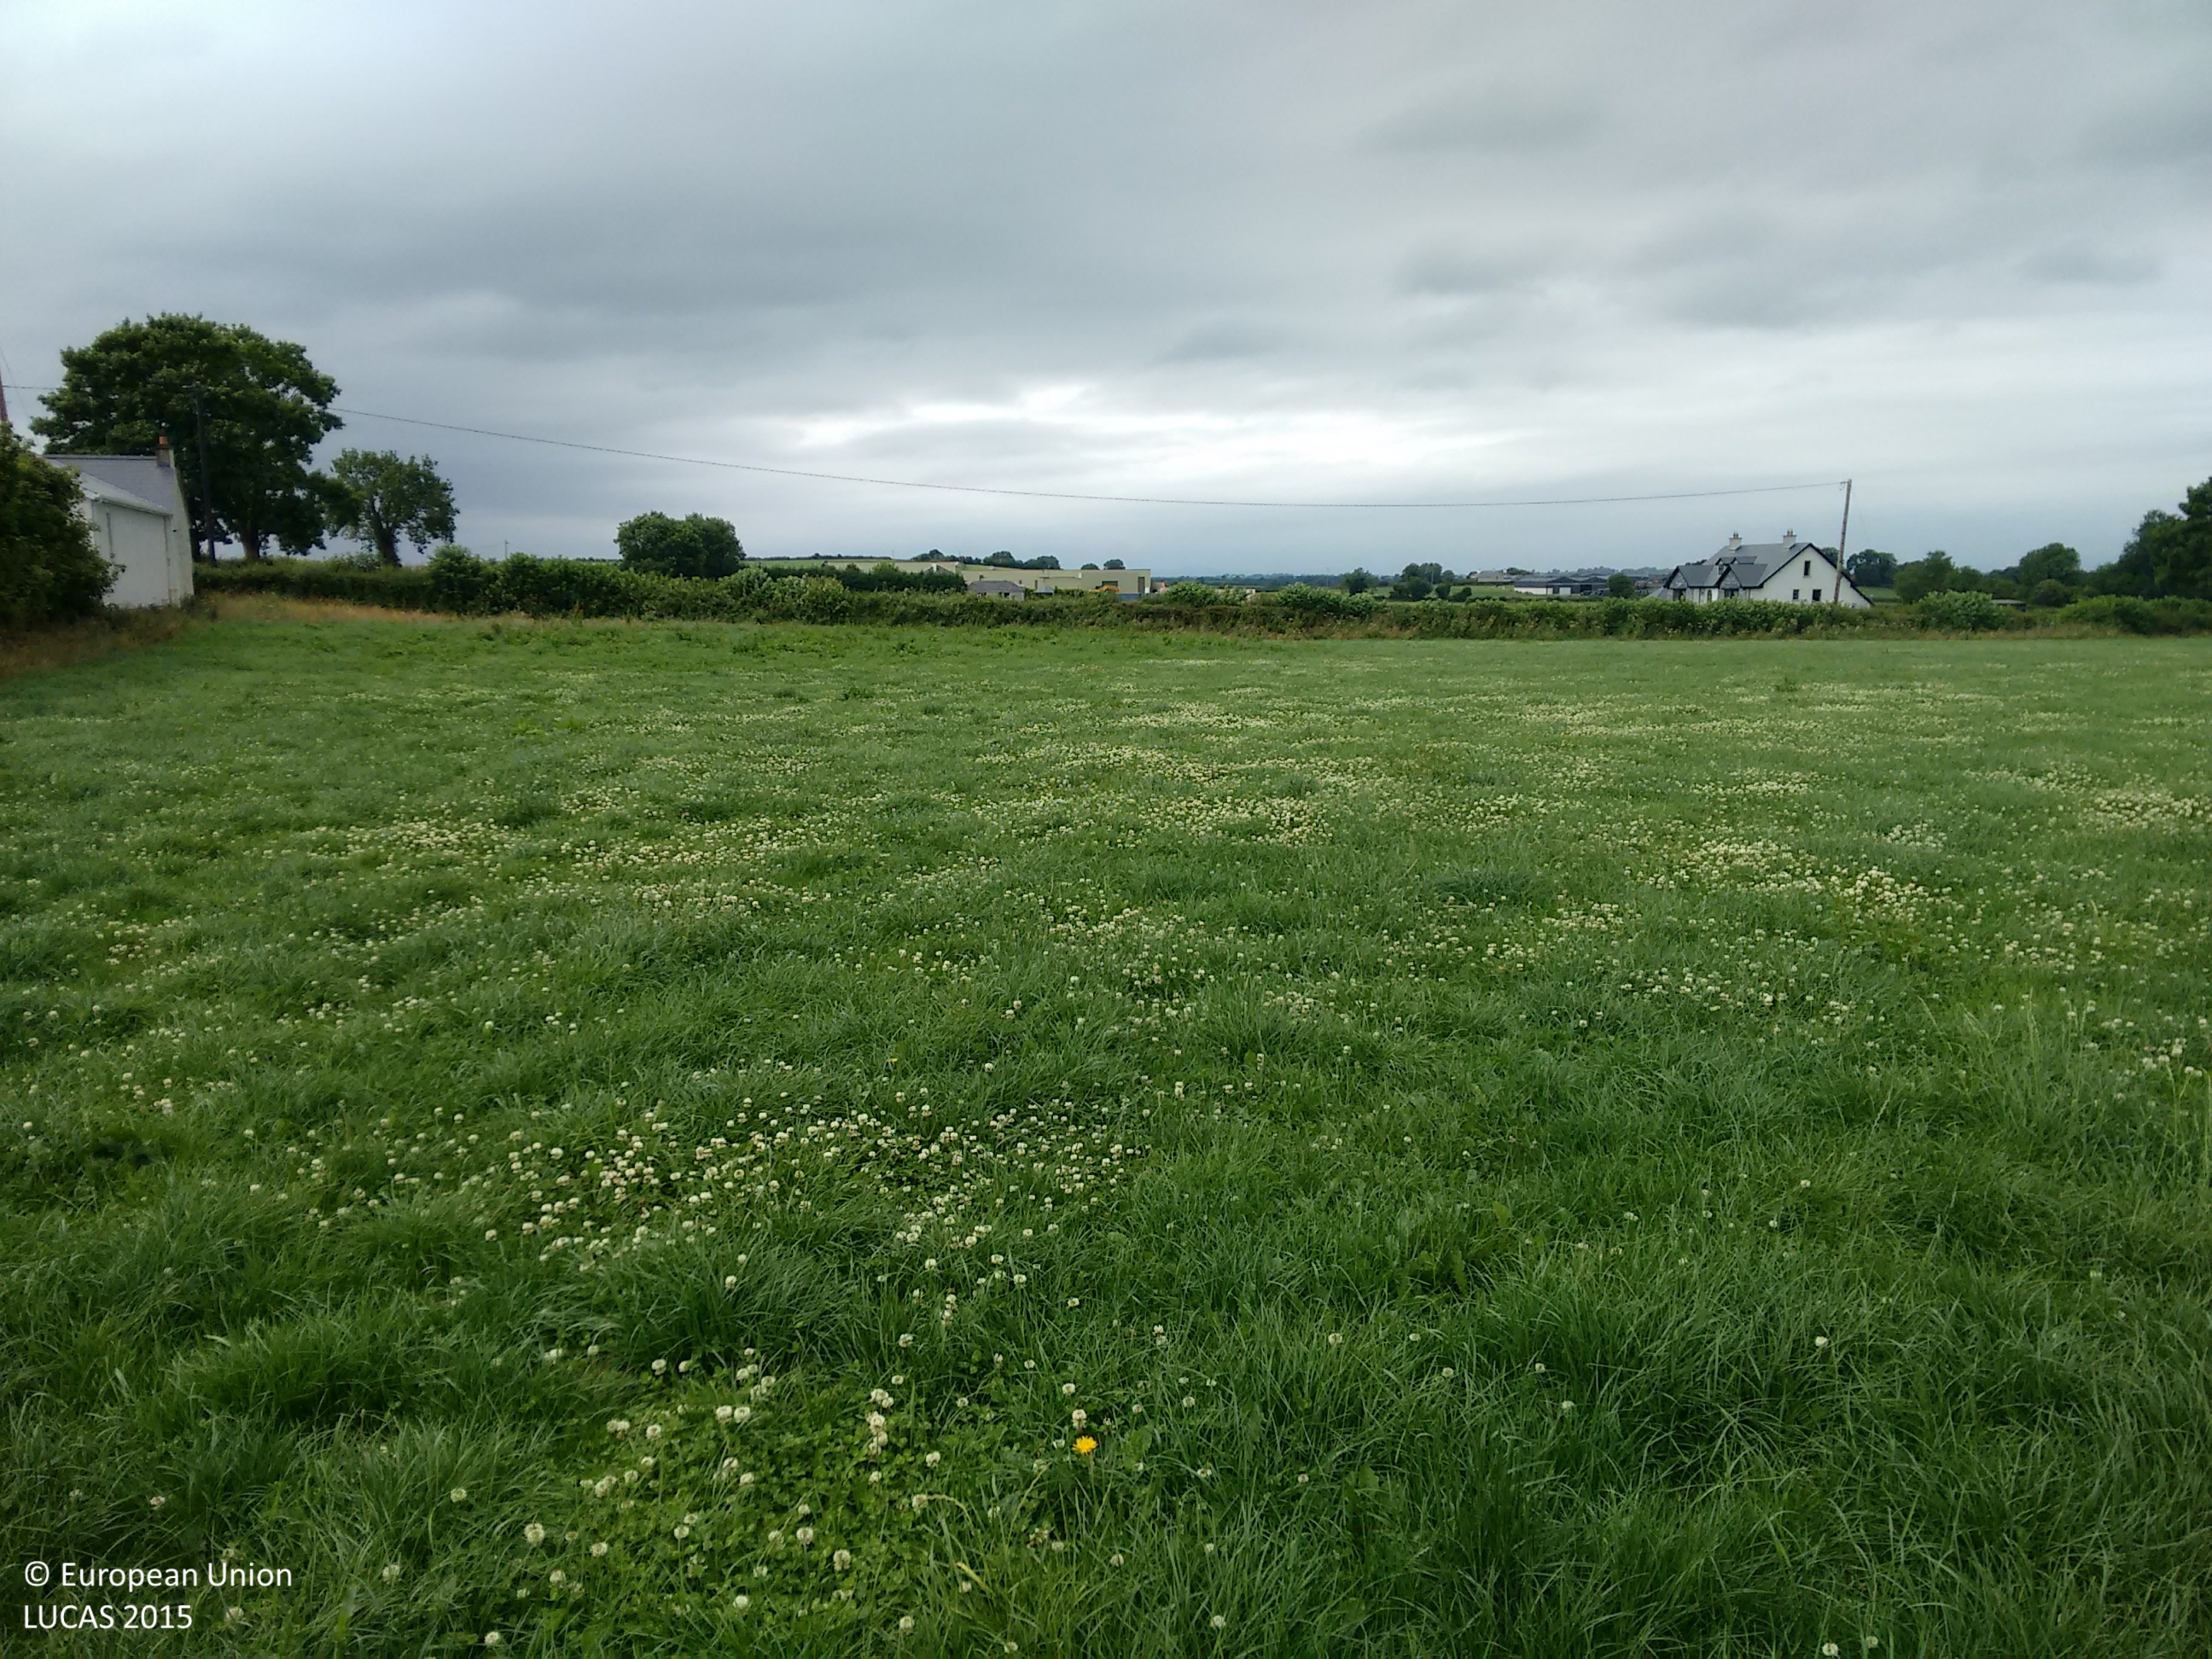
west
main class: Grassland
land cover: Grassland without tree/shrub cover
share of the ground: > 75 %
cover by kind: herbaceous plants 95 %, unconsolidated bare surface 5 %
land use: Agriculture (excluding fallow land and kitchen gardens)
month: July
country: IE
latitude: 52.6996
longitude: -7.5175
